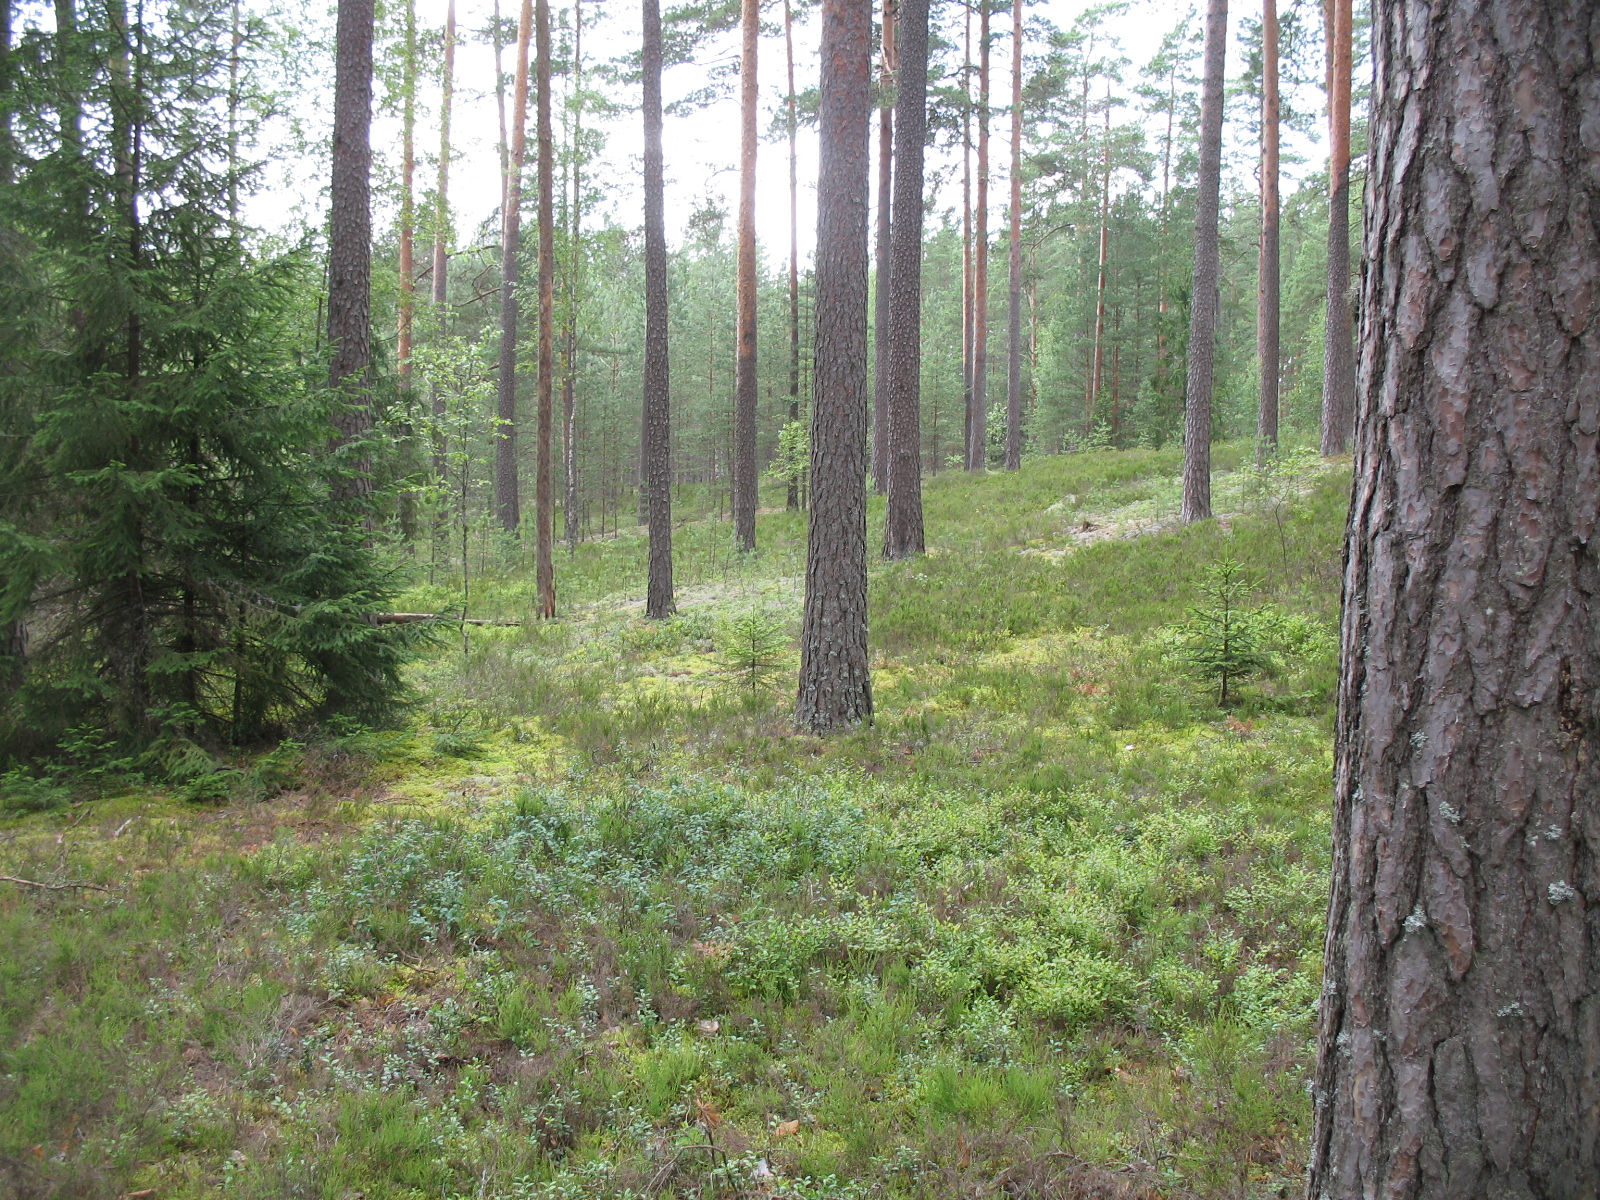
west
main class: Woodland
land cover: Pine dominated coniferous woodland
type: hemiboreal forest and nemoral coniferous forest and mixed broadleaved-coniferous forest
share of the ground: 50 - 75 %
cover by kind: coniferous forest trees 70 %, herbaceous plants 15 %, lichens and mosses 15 %
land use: Forestry
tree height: > 5 m
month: July
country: LV
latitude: 56.5176
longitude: 25.0784
